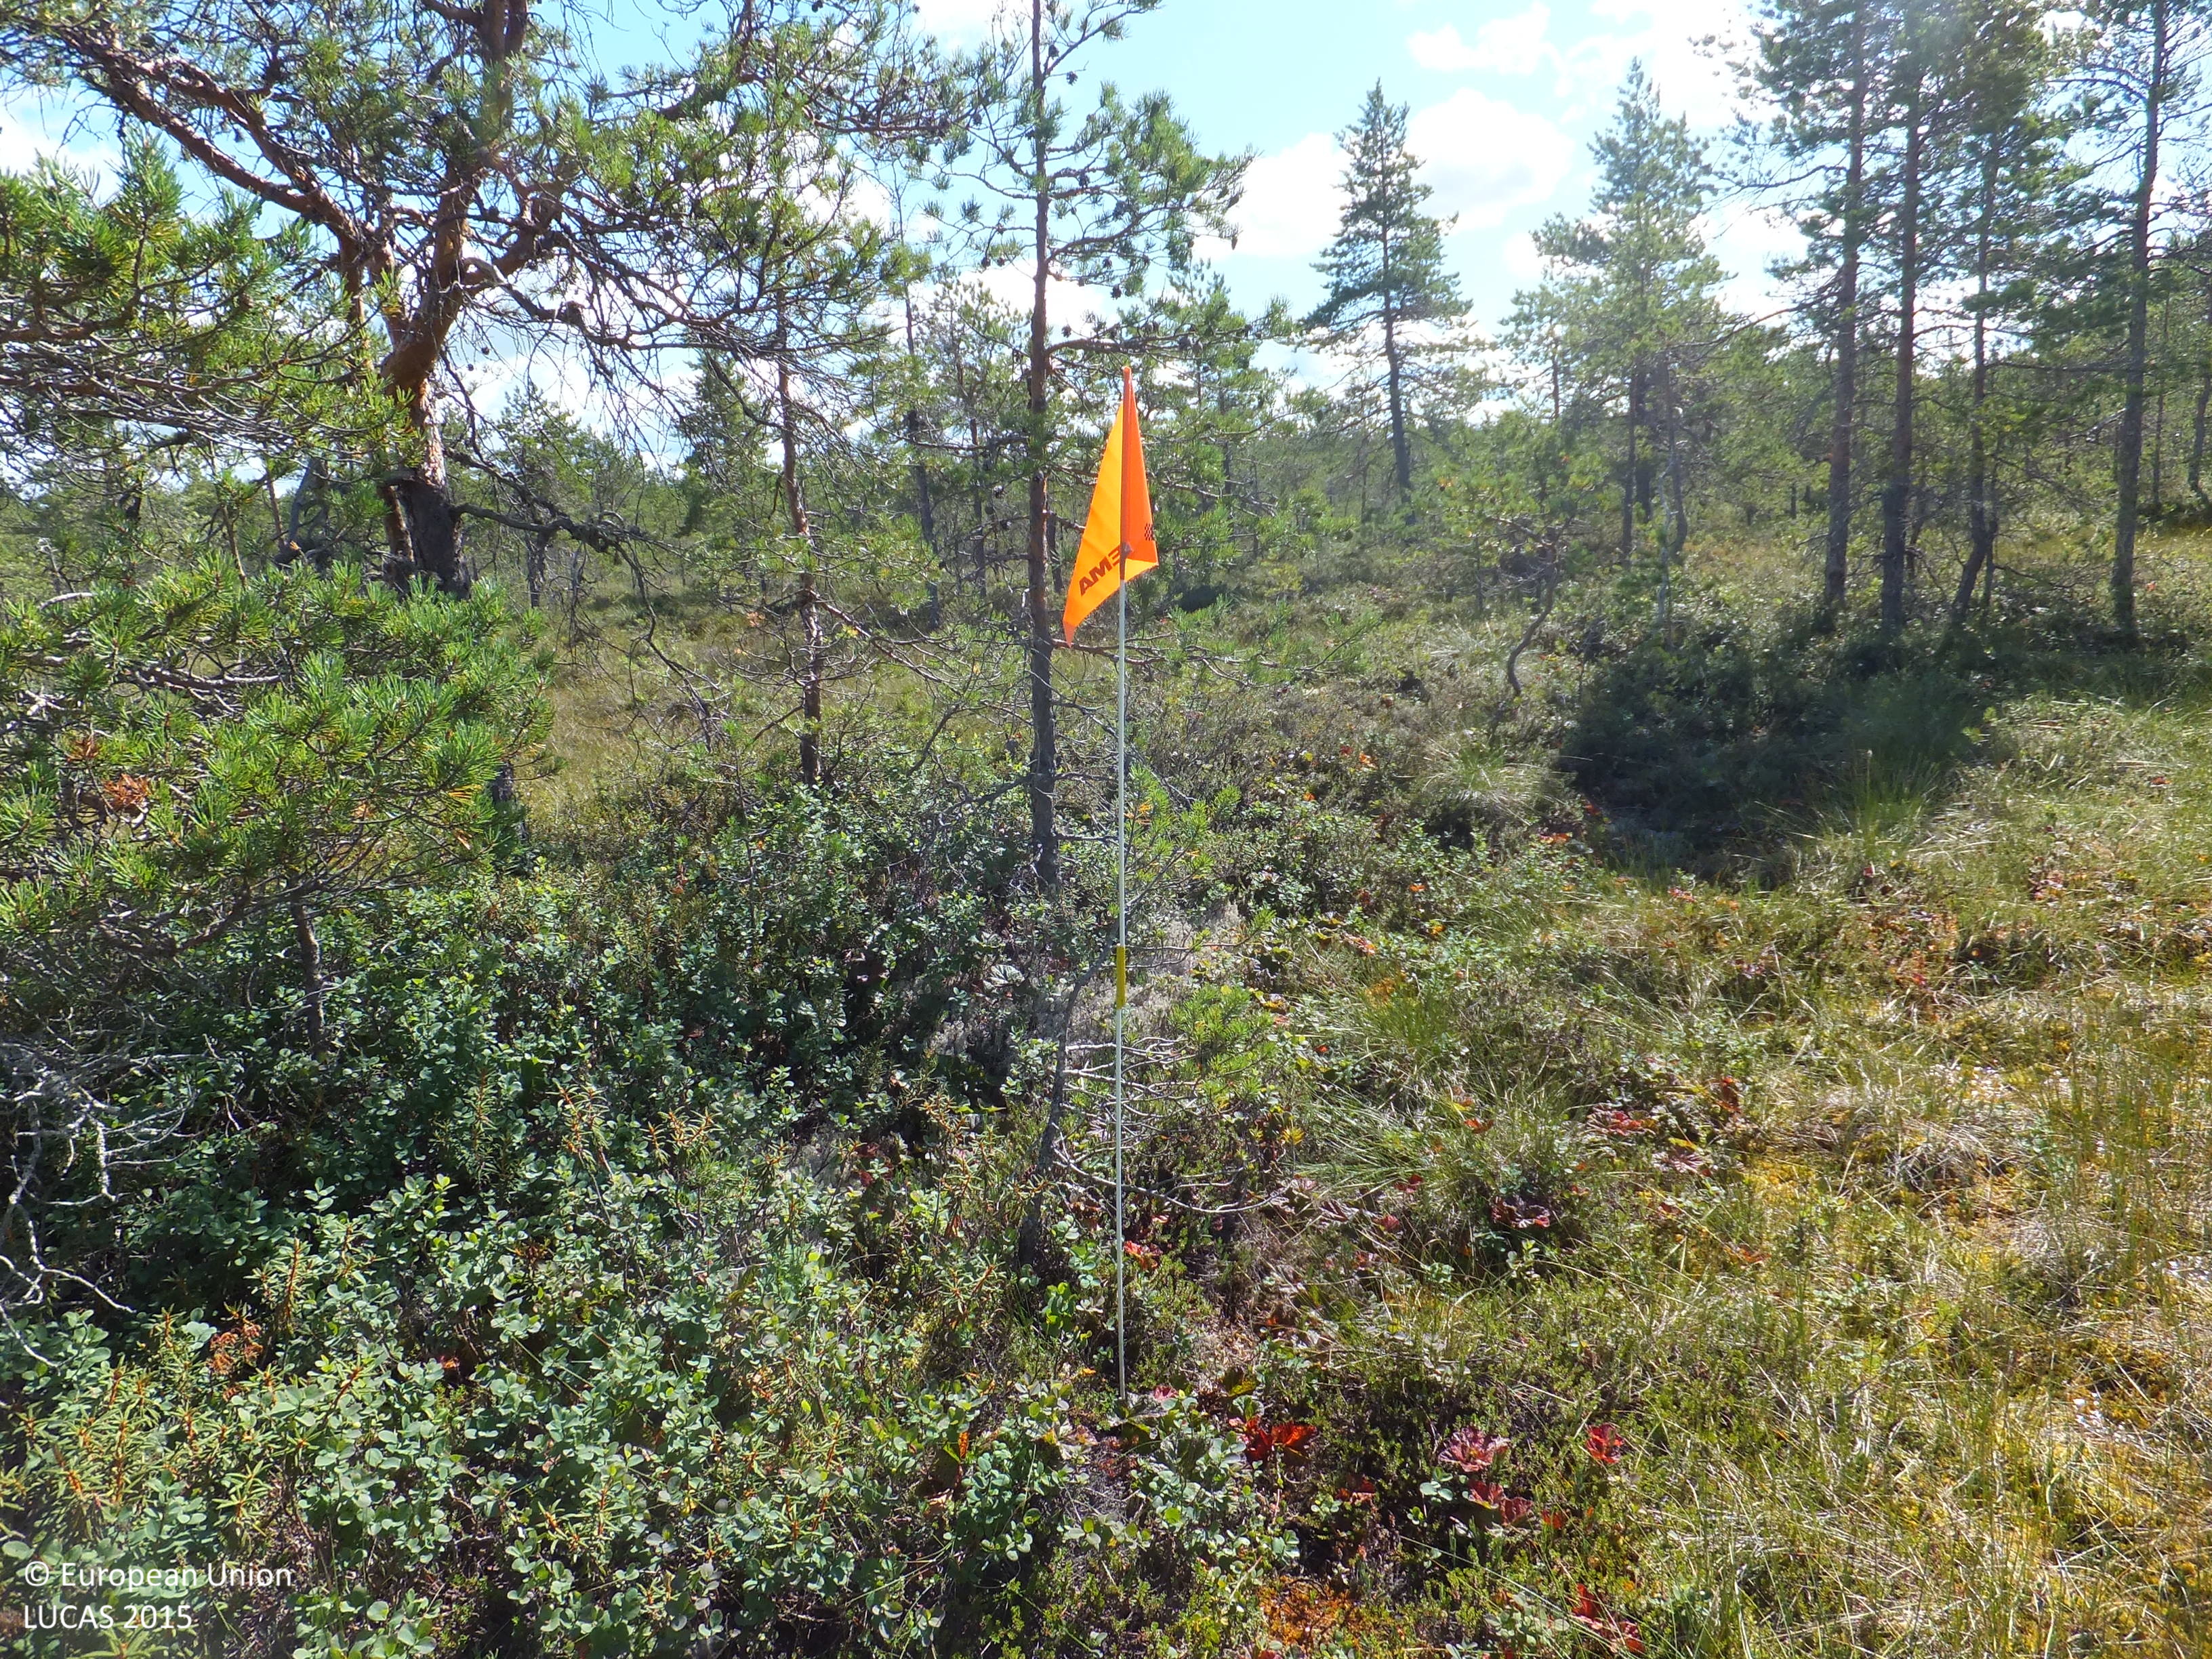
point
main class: Woodland
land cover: Pine dominated coniferous woodland
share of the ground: 10 - 25 %
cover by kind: shrubs 30 %, lichens and mosses 30 %, coniferous forest trees 20 %, herbaceous plants 20 %
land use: Forestry
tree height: < 5 m
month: August
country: FI
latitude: 63.0997
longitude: 22.6729
